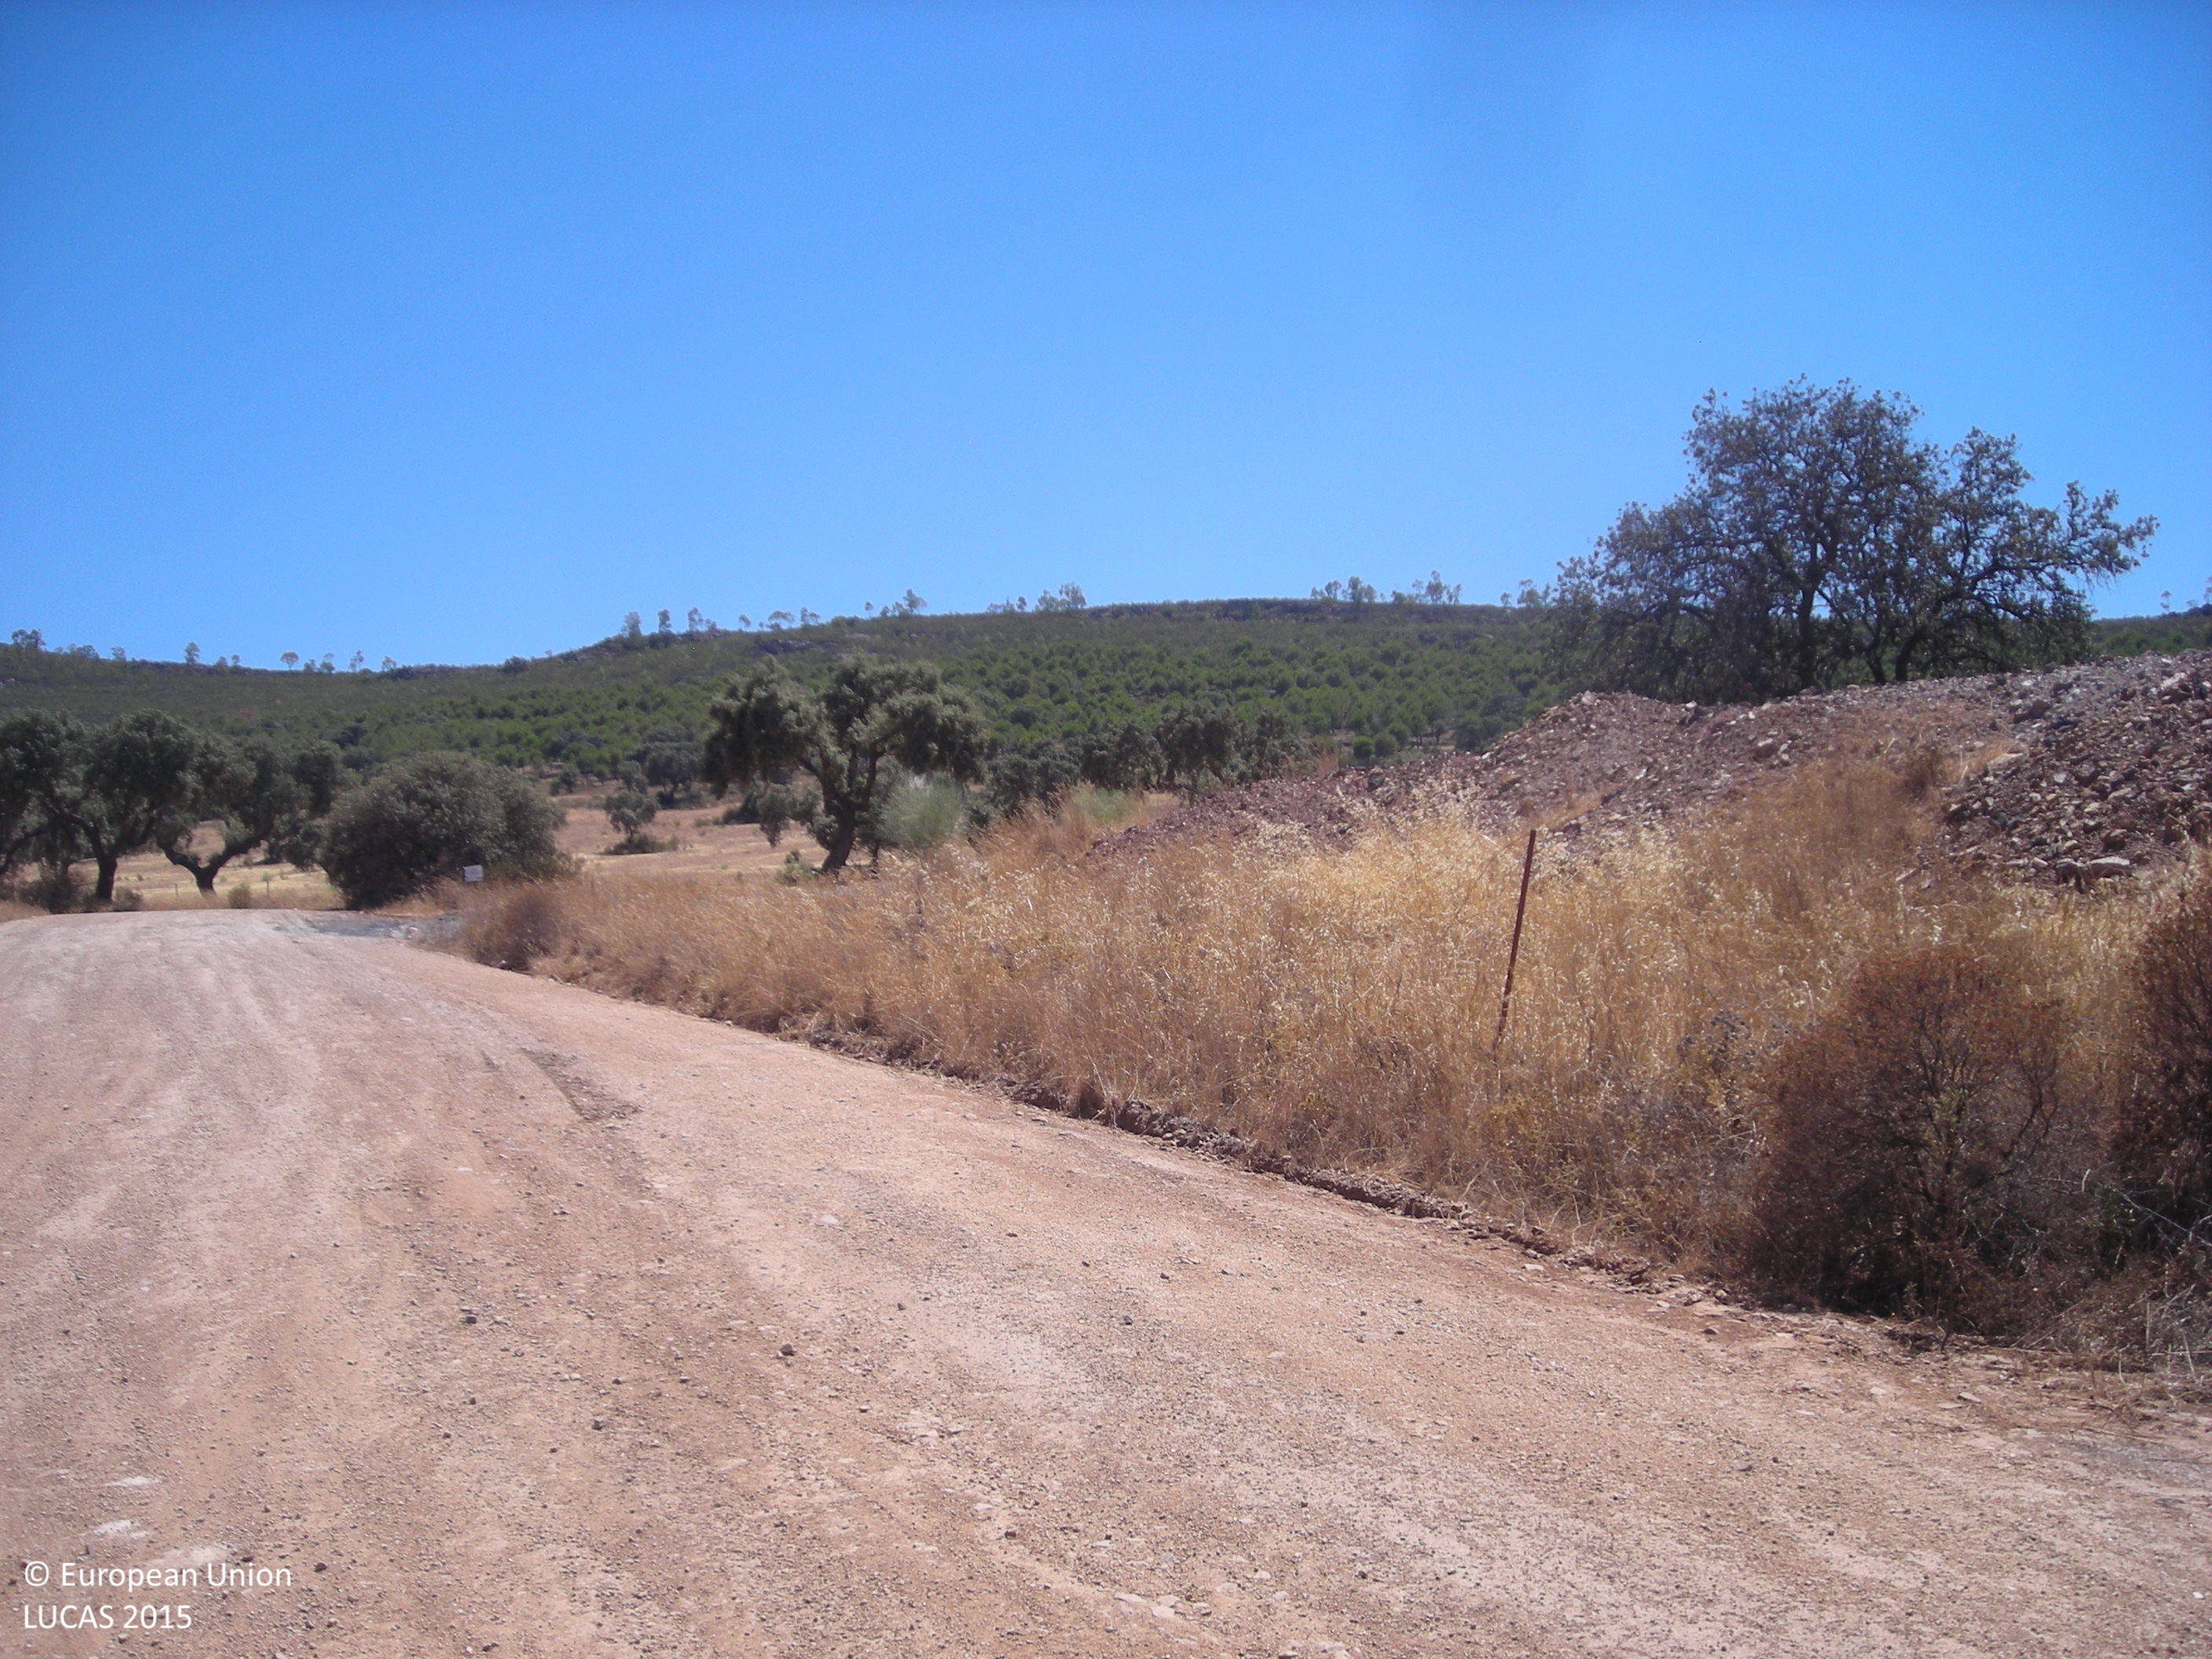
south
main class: Shrubland
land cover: Shrubland with sparse tree cover
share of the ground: > 75 %
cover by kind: shrubs 95 %, broadleaved forest trees 5 %
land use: Semi-natural and natural areas not in use
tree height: > 5 m
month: July
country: ES
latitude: 38.8104
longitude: -5.8114
